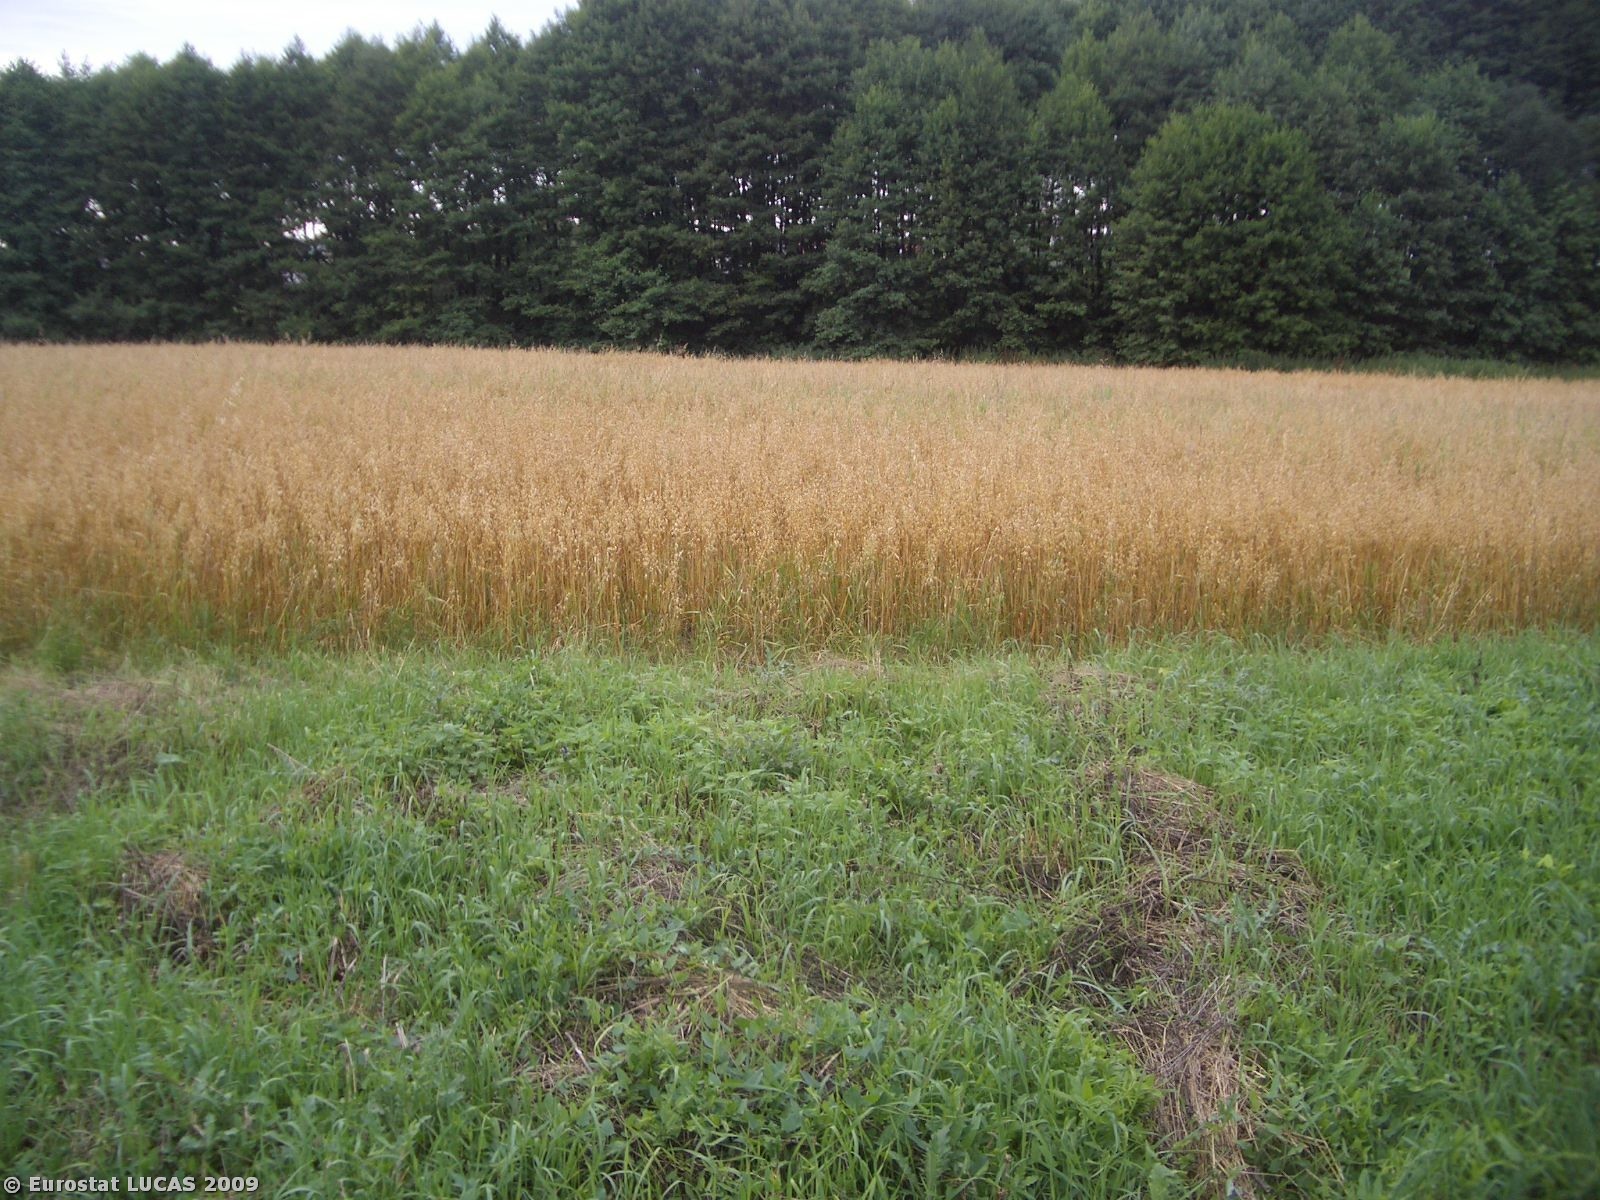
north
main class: Grassland
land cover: Grassland without tree/shrub cover
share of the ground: > 75 %
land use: Residential
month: August
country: PL
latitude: 53.1116
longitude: 23.2100
